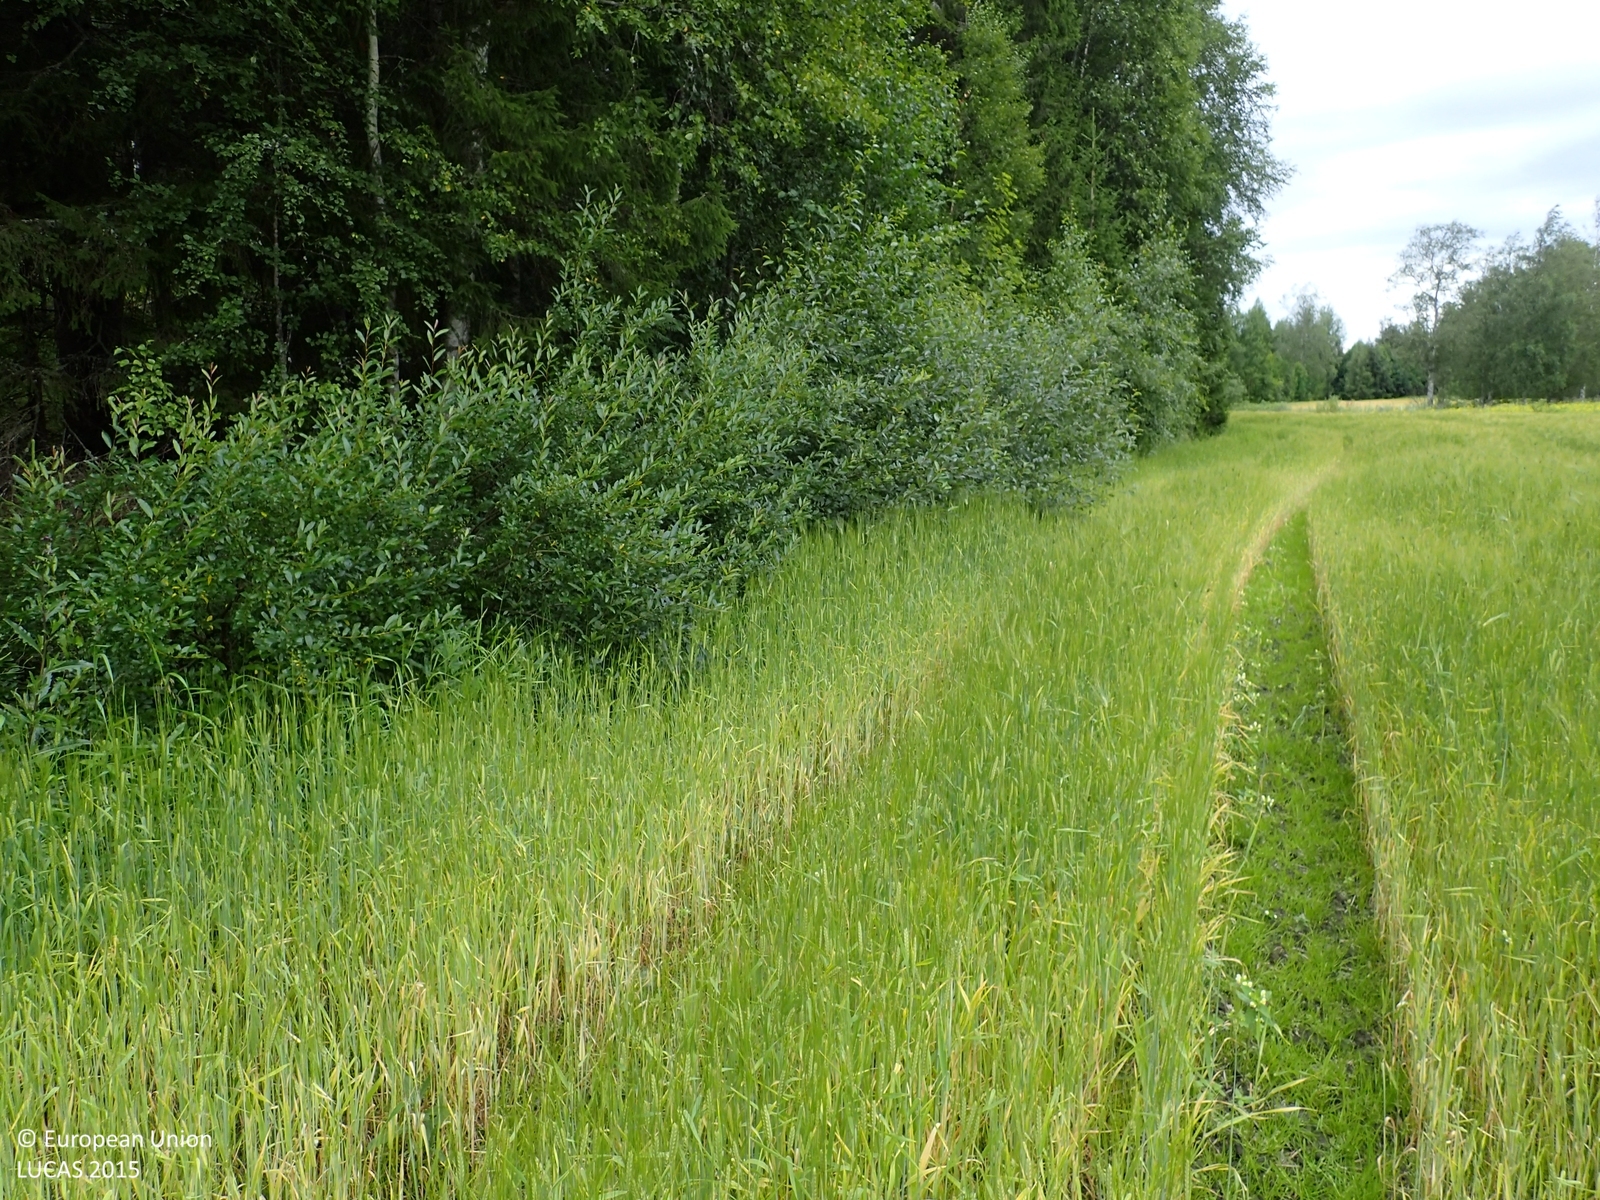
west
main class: Cropland
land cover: Barley
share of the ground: > 75 %
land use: Agriculture (excluding fallow land and kitchen gardens)
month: August
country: FI
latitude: 62.9639
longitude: 22.0952
